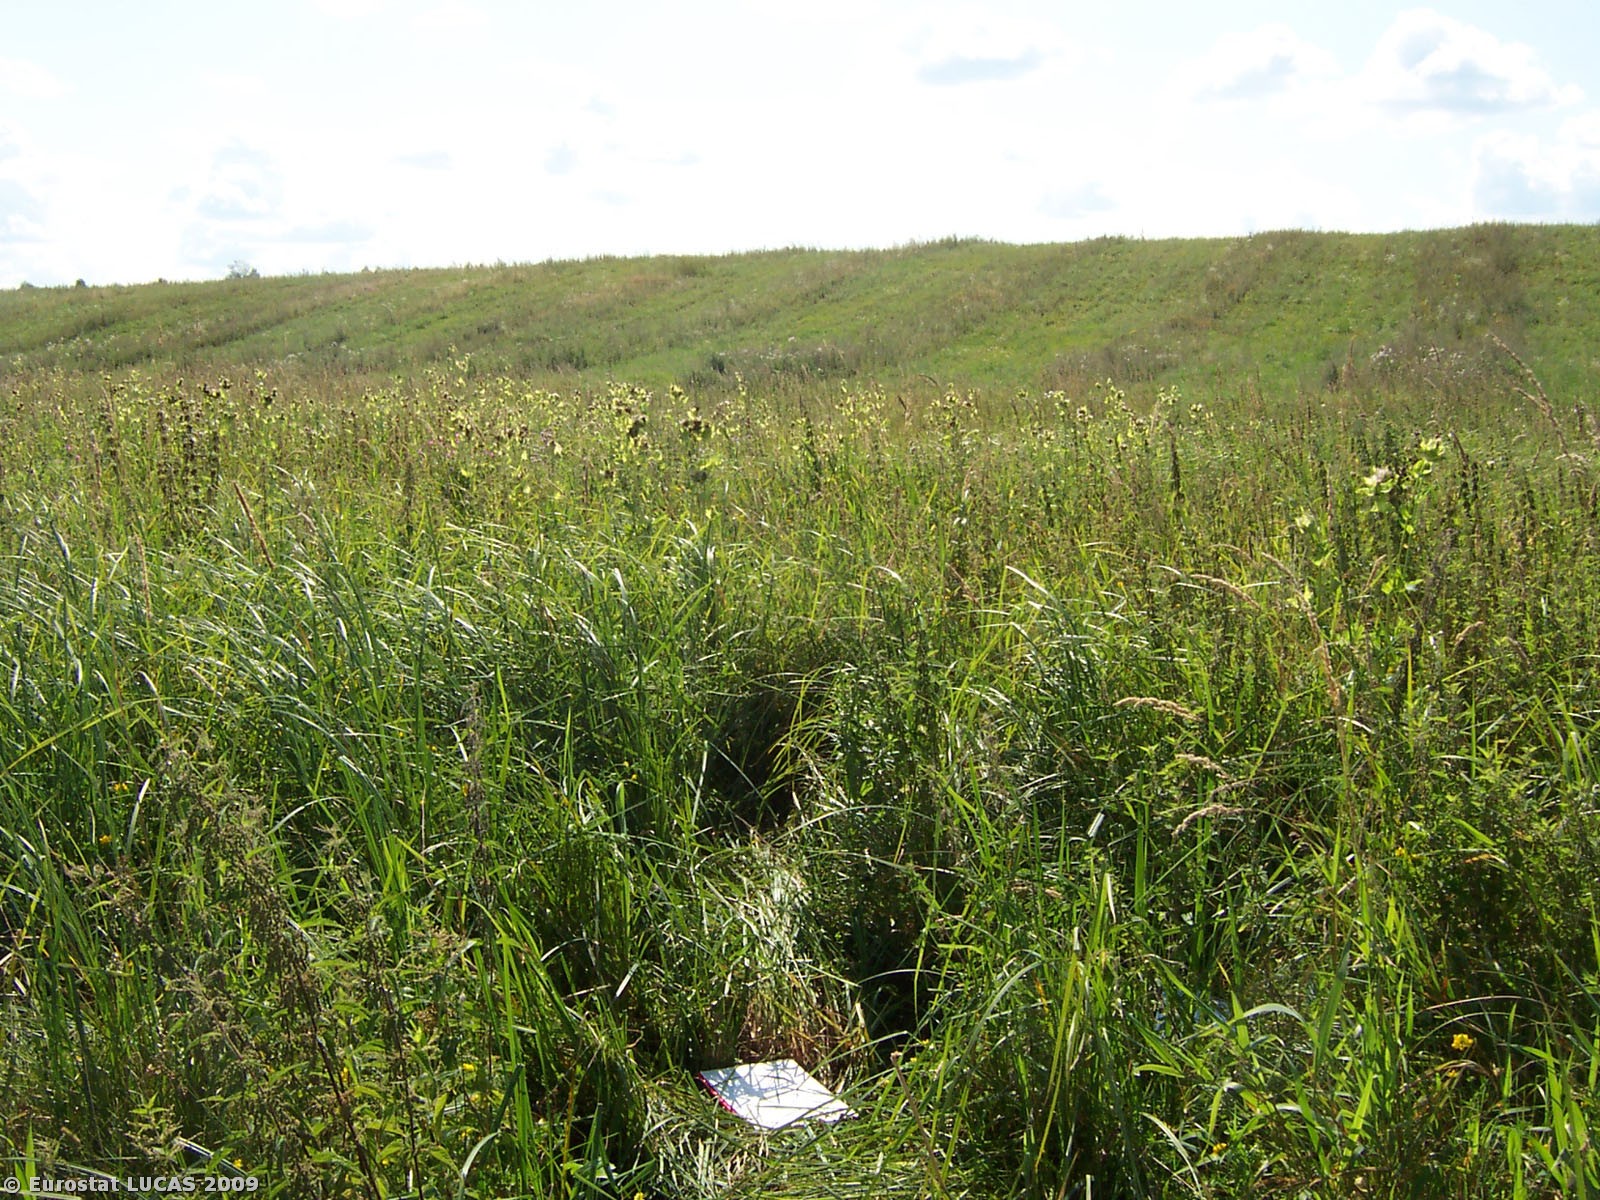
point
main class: Grassland
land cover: Spontaneously vegetated surfaces
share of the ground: > 75 %
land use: Nature reserves
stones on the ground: < 10 %
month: August
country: PL
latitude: 53.7611
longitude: 21.1025
